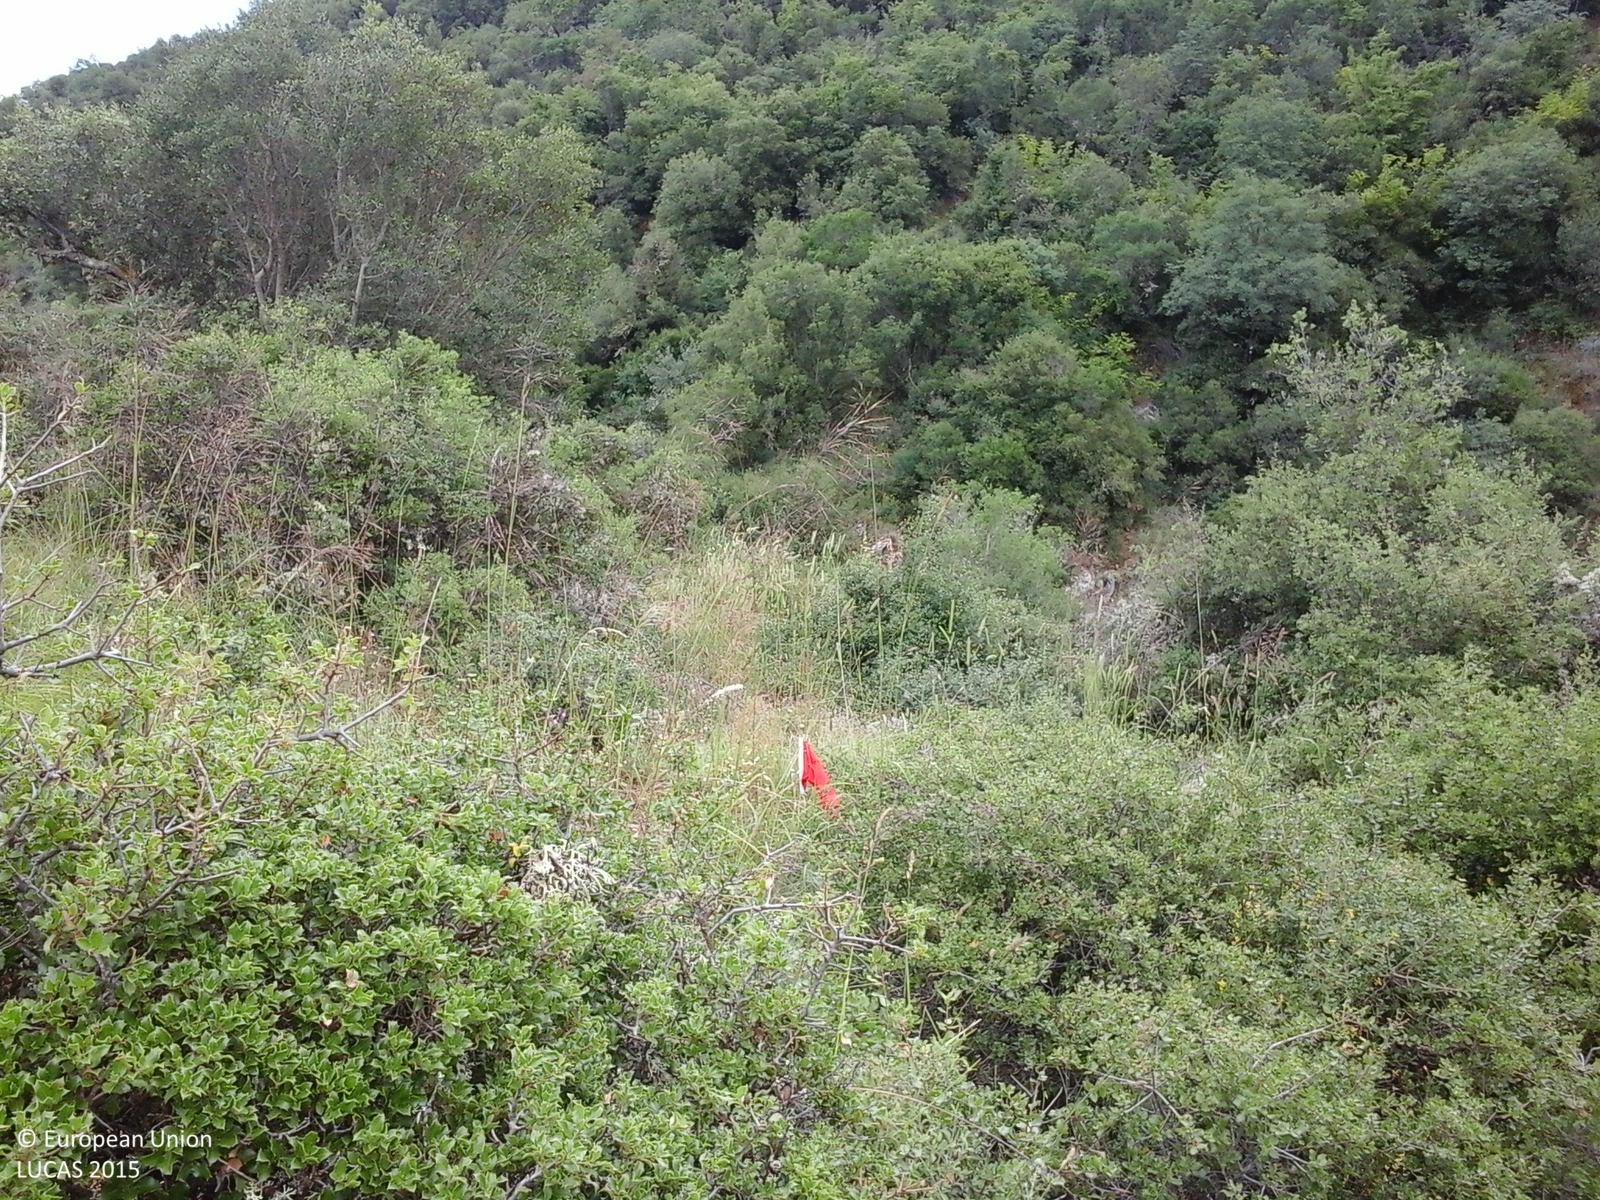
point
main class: Shrubland
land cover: Shrubland without tree cover
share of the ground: > 75 %
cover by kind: shrubs 90 %, herbaceous plants 10 %
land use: Semi-natural and natural areas not in use
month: June
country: GR
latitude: 40.7238
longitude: 23.2121
